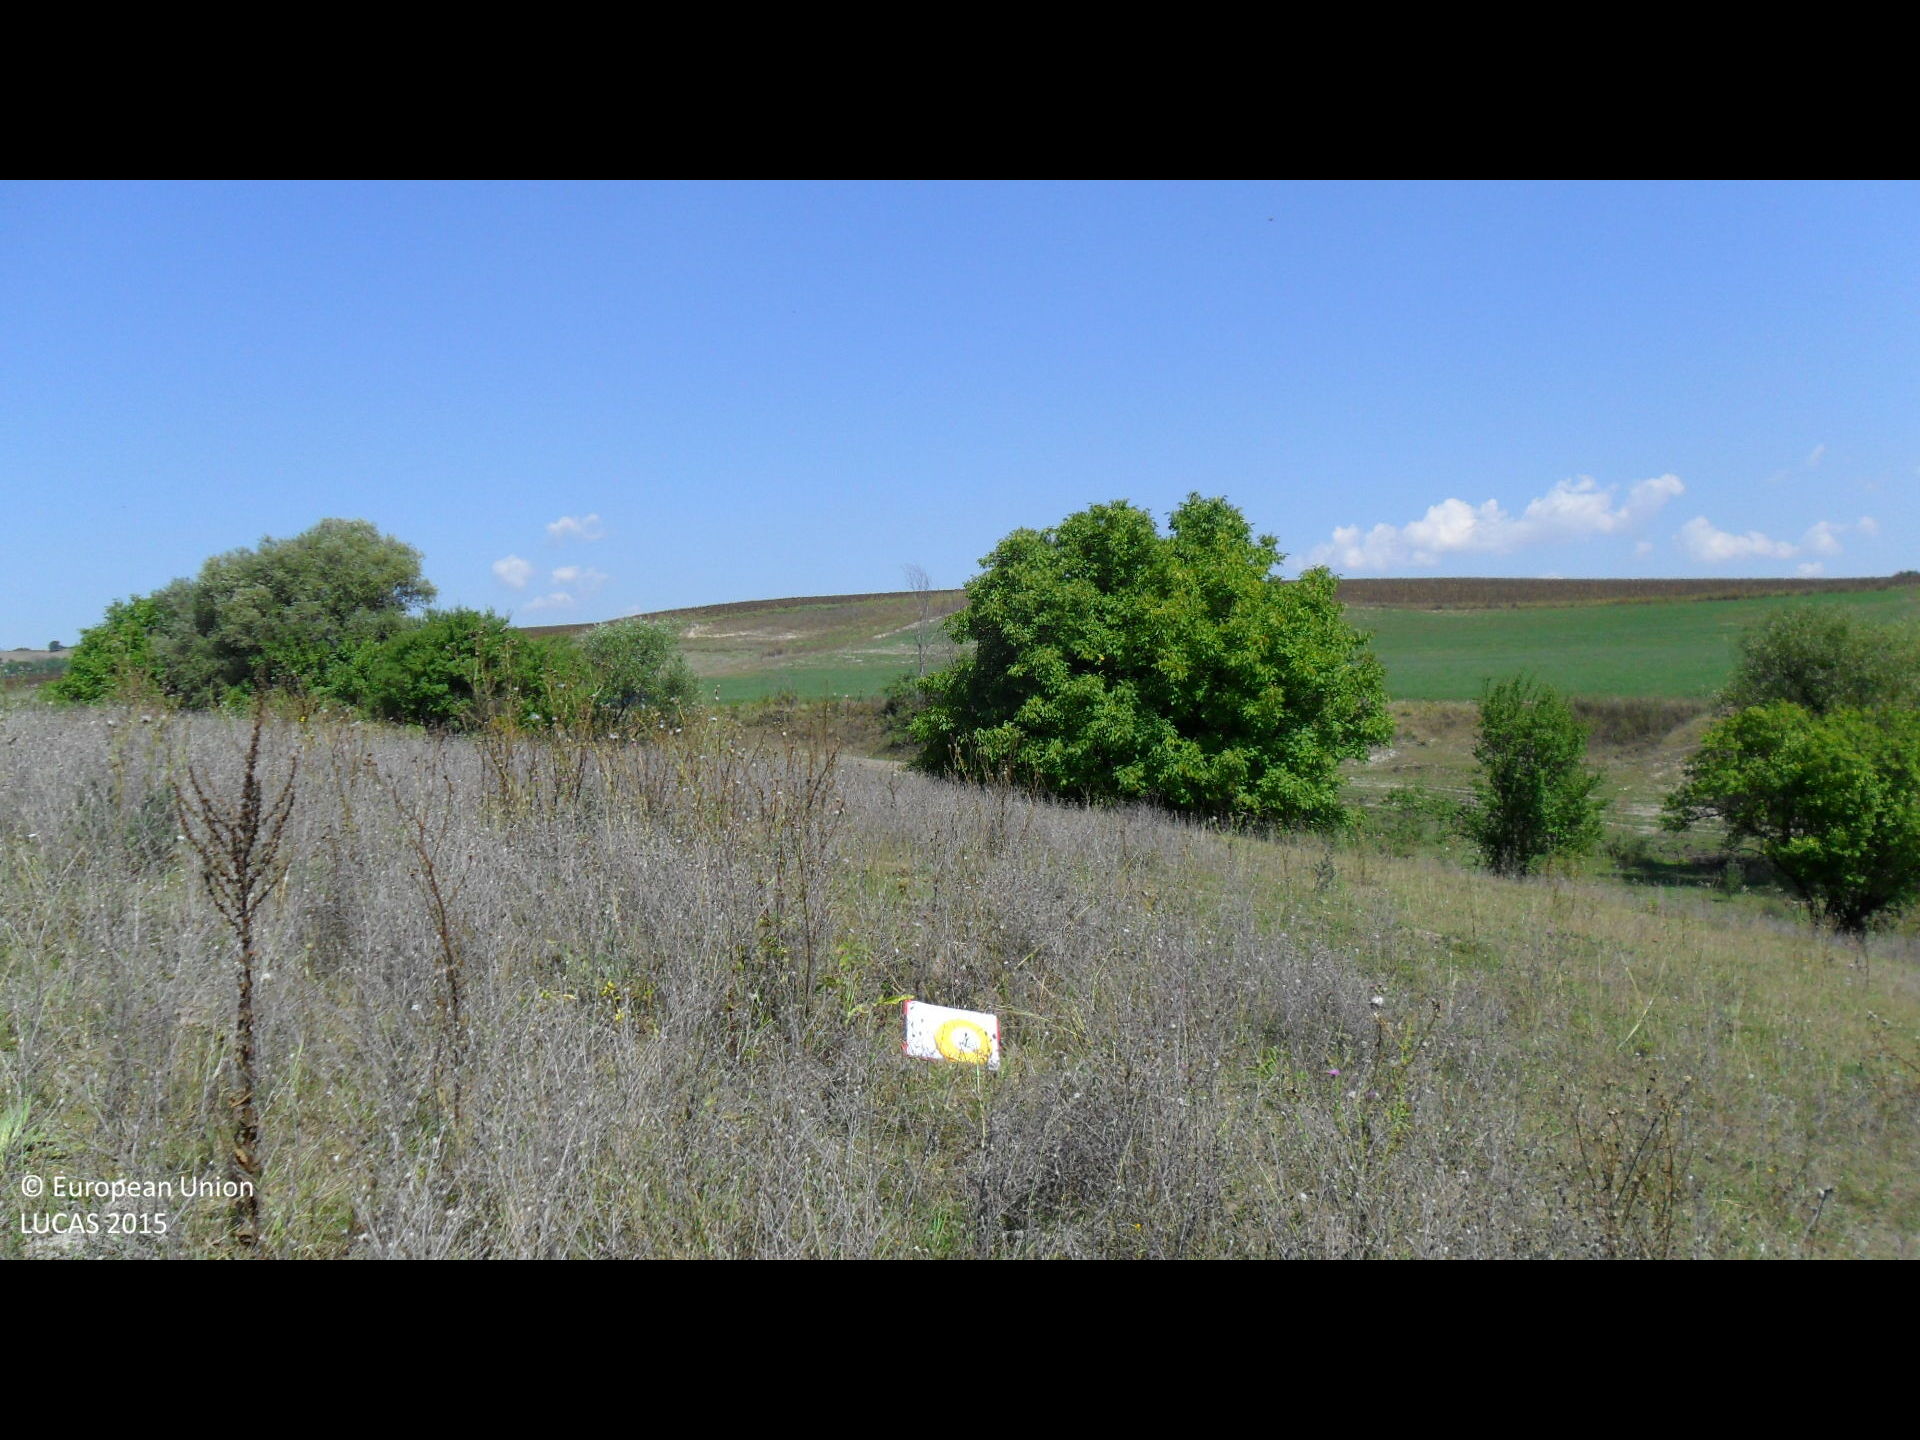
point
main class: Grassland
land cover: Grassland without tree/shrub cover
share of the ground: > 75 %
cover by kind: herbaceous plants 100 %
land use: Agriculture (excluding fallow land and kitchen gardens)
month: August
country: BG
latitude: 43.4377
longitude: 26.2961
